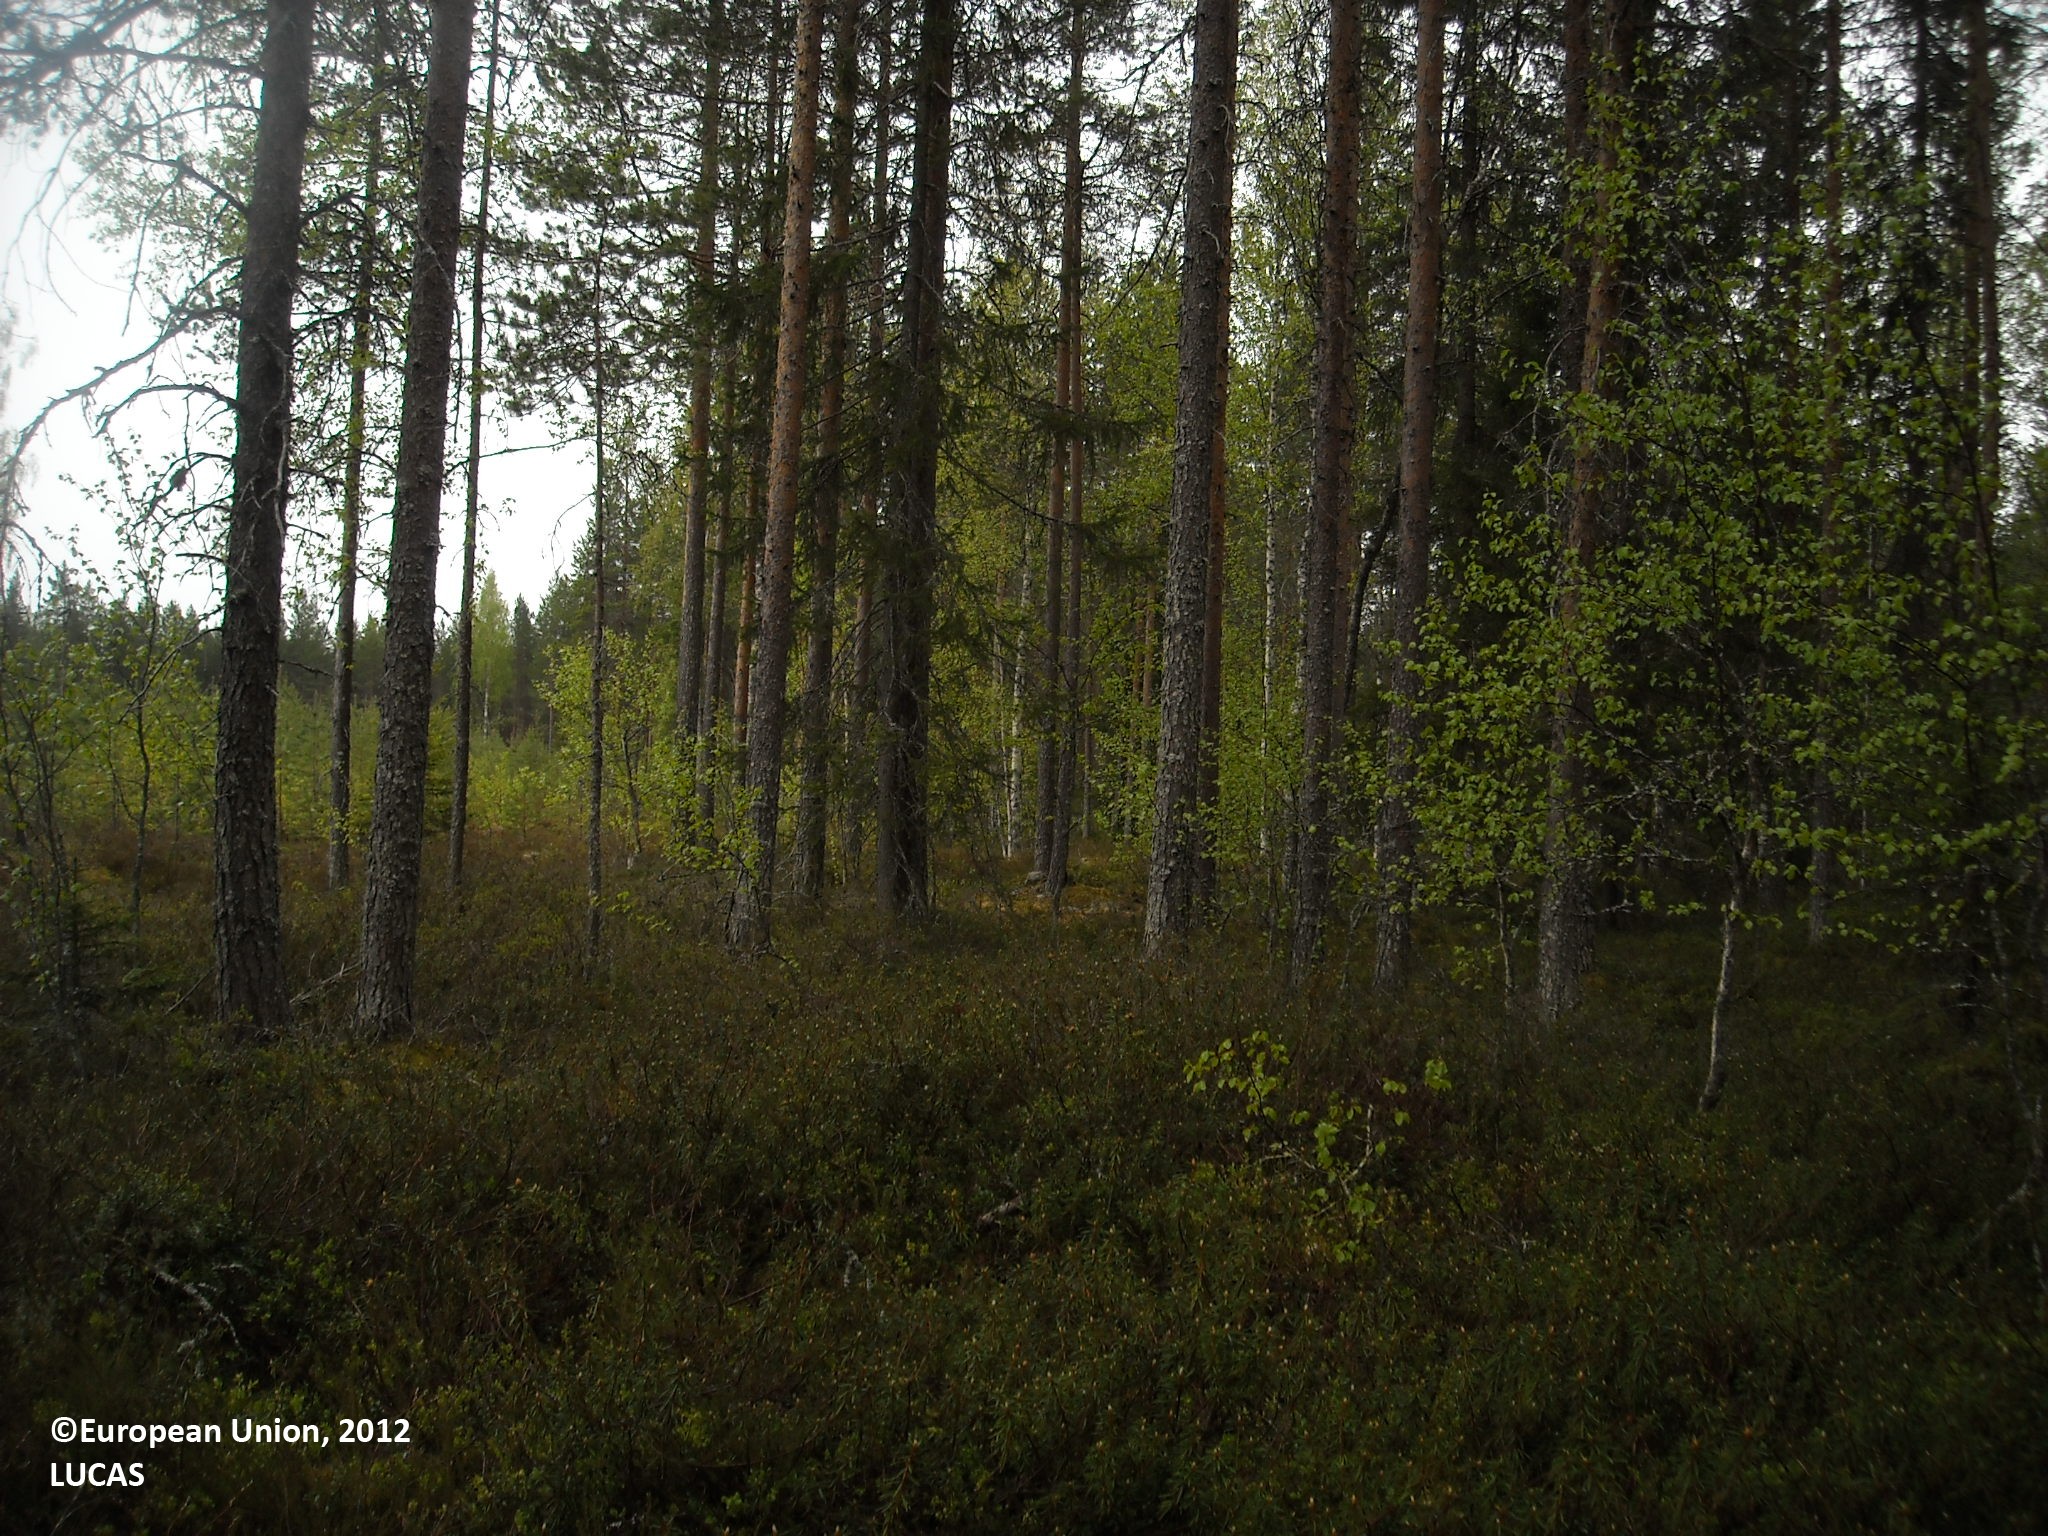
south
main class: Woodland
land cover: Pine dominated mixed woodland
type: boreal forest
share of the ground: > 75 %
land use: Forestry
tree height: > 5 m
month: June
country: FI
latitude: 64.6521
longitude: 27.2370
